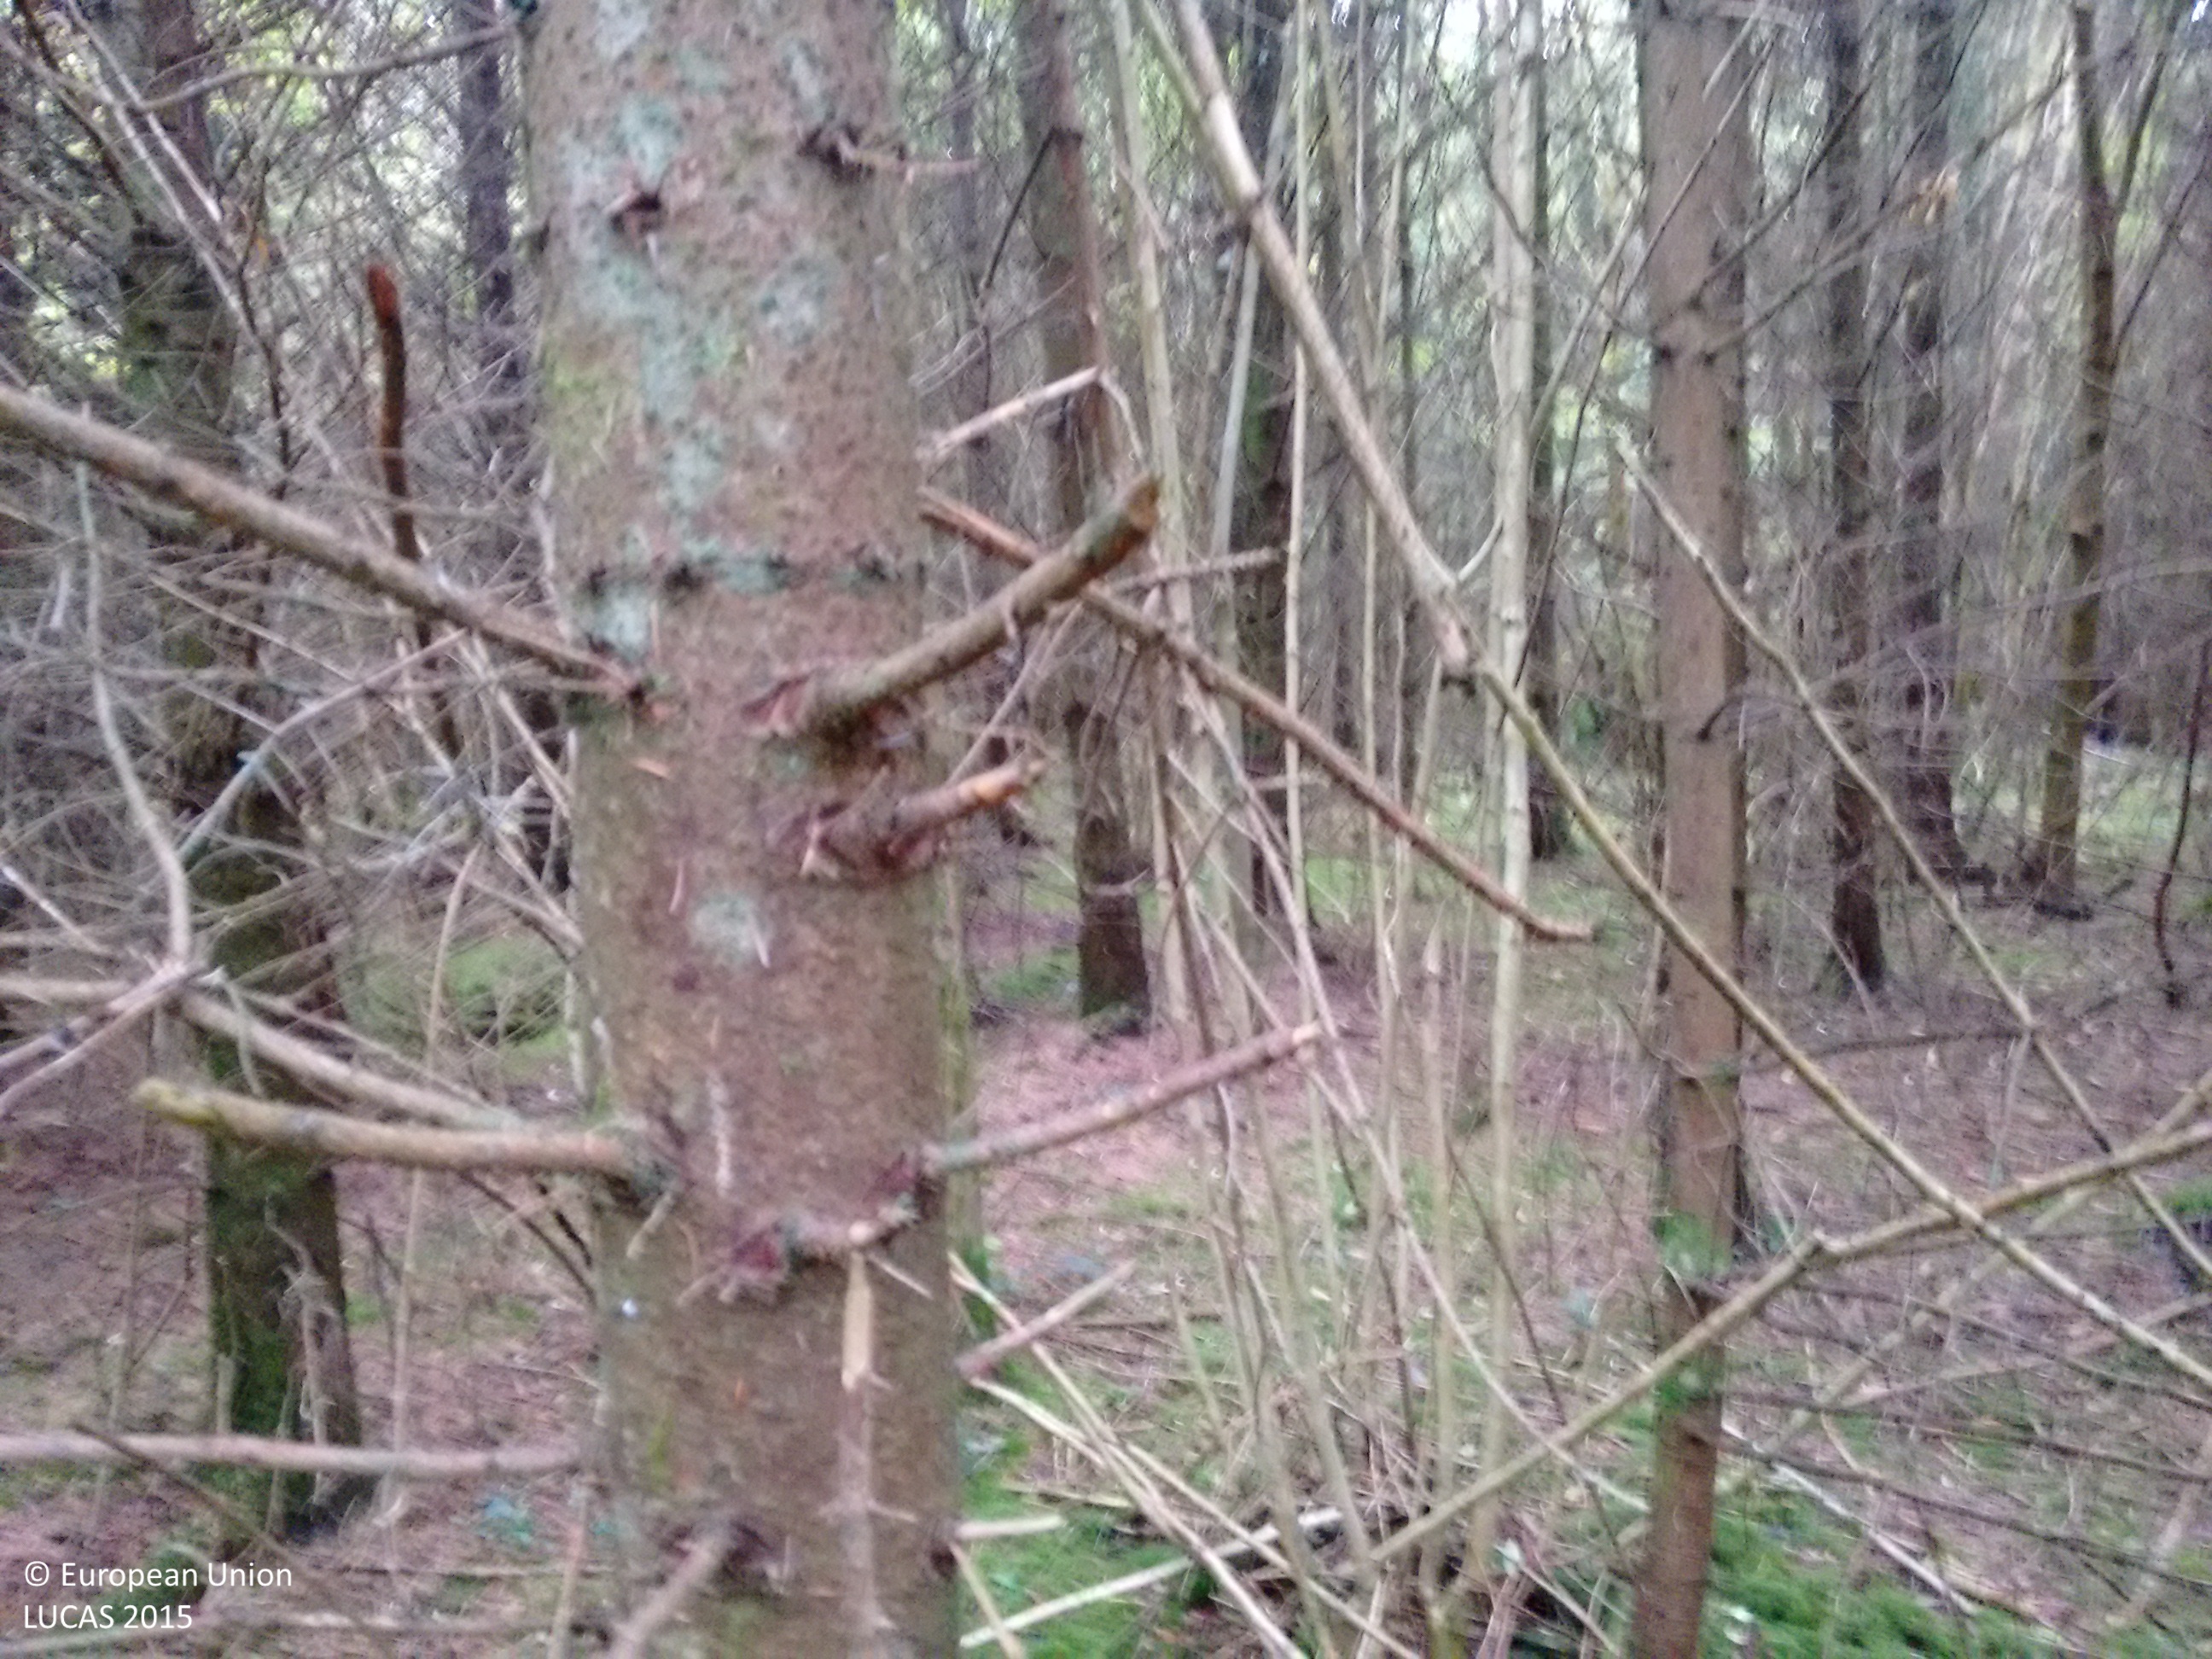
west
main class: Woodland
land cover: Spruce dominated mixed woodland
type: exotic forest
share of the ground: > 75 %
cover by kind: coniferous forest trees 75 %, broadleaved forest trees 25 %
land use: Forestry
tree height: > 5 m
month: October
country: IE
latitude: 52.8427
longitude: -7.4228
